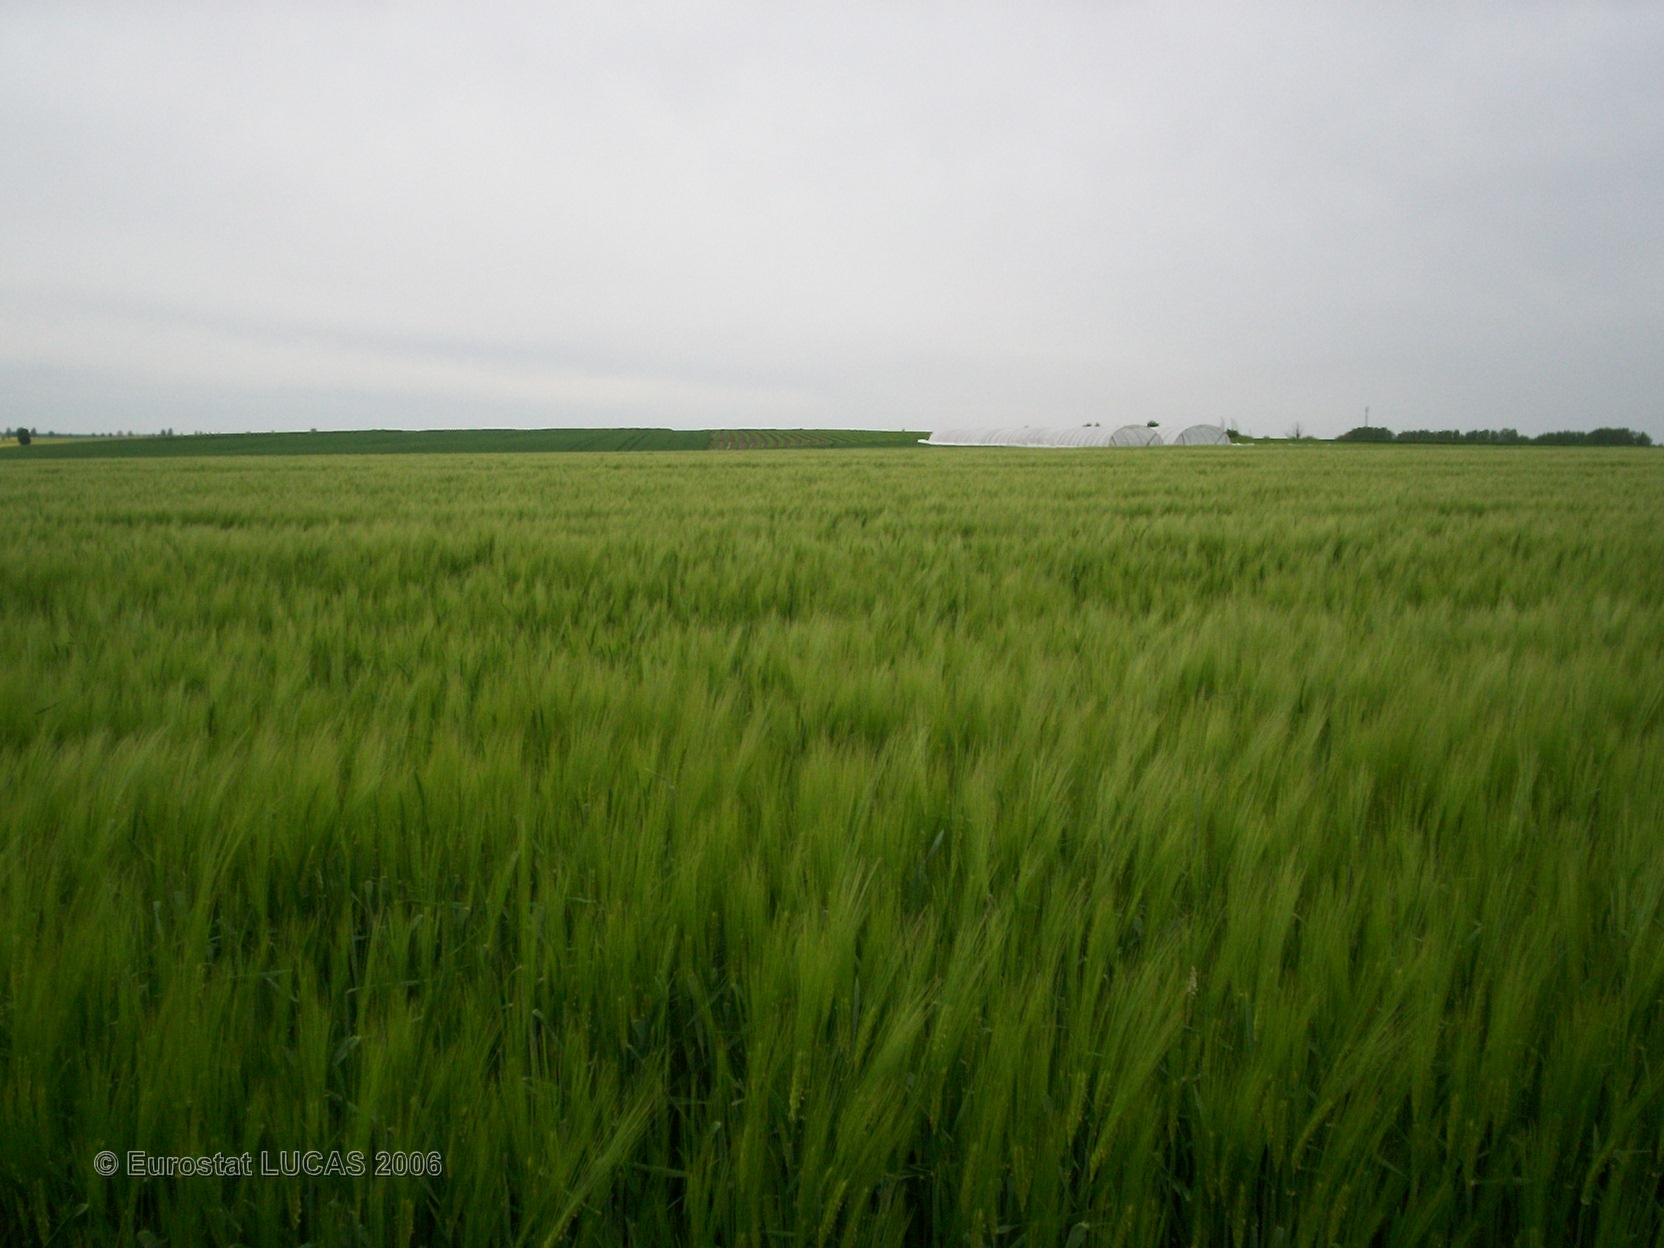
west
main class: Cropland
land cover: Barley
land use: Agriculture (excluding fallow land and kitchen gardens)
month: May
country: FR
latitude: 50.3434
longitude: 2.6391
